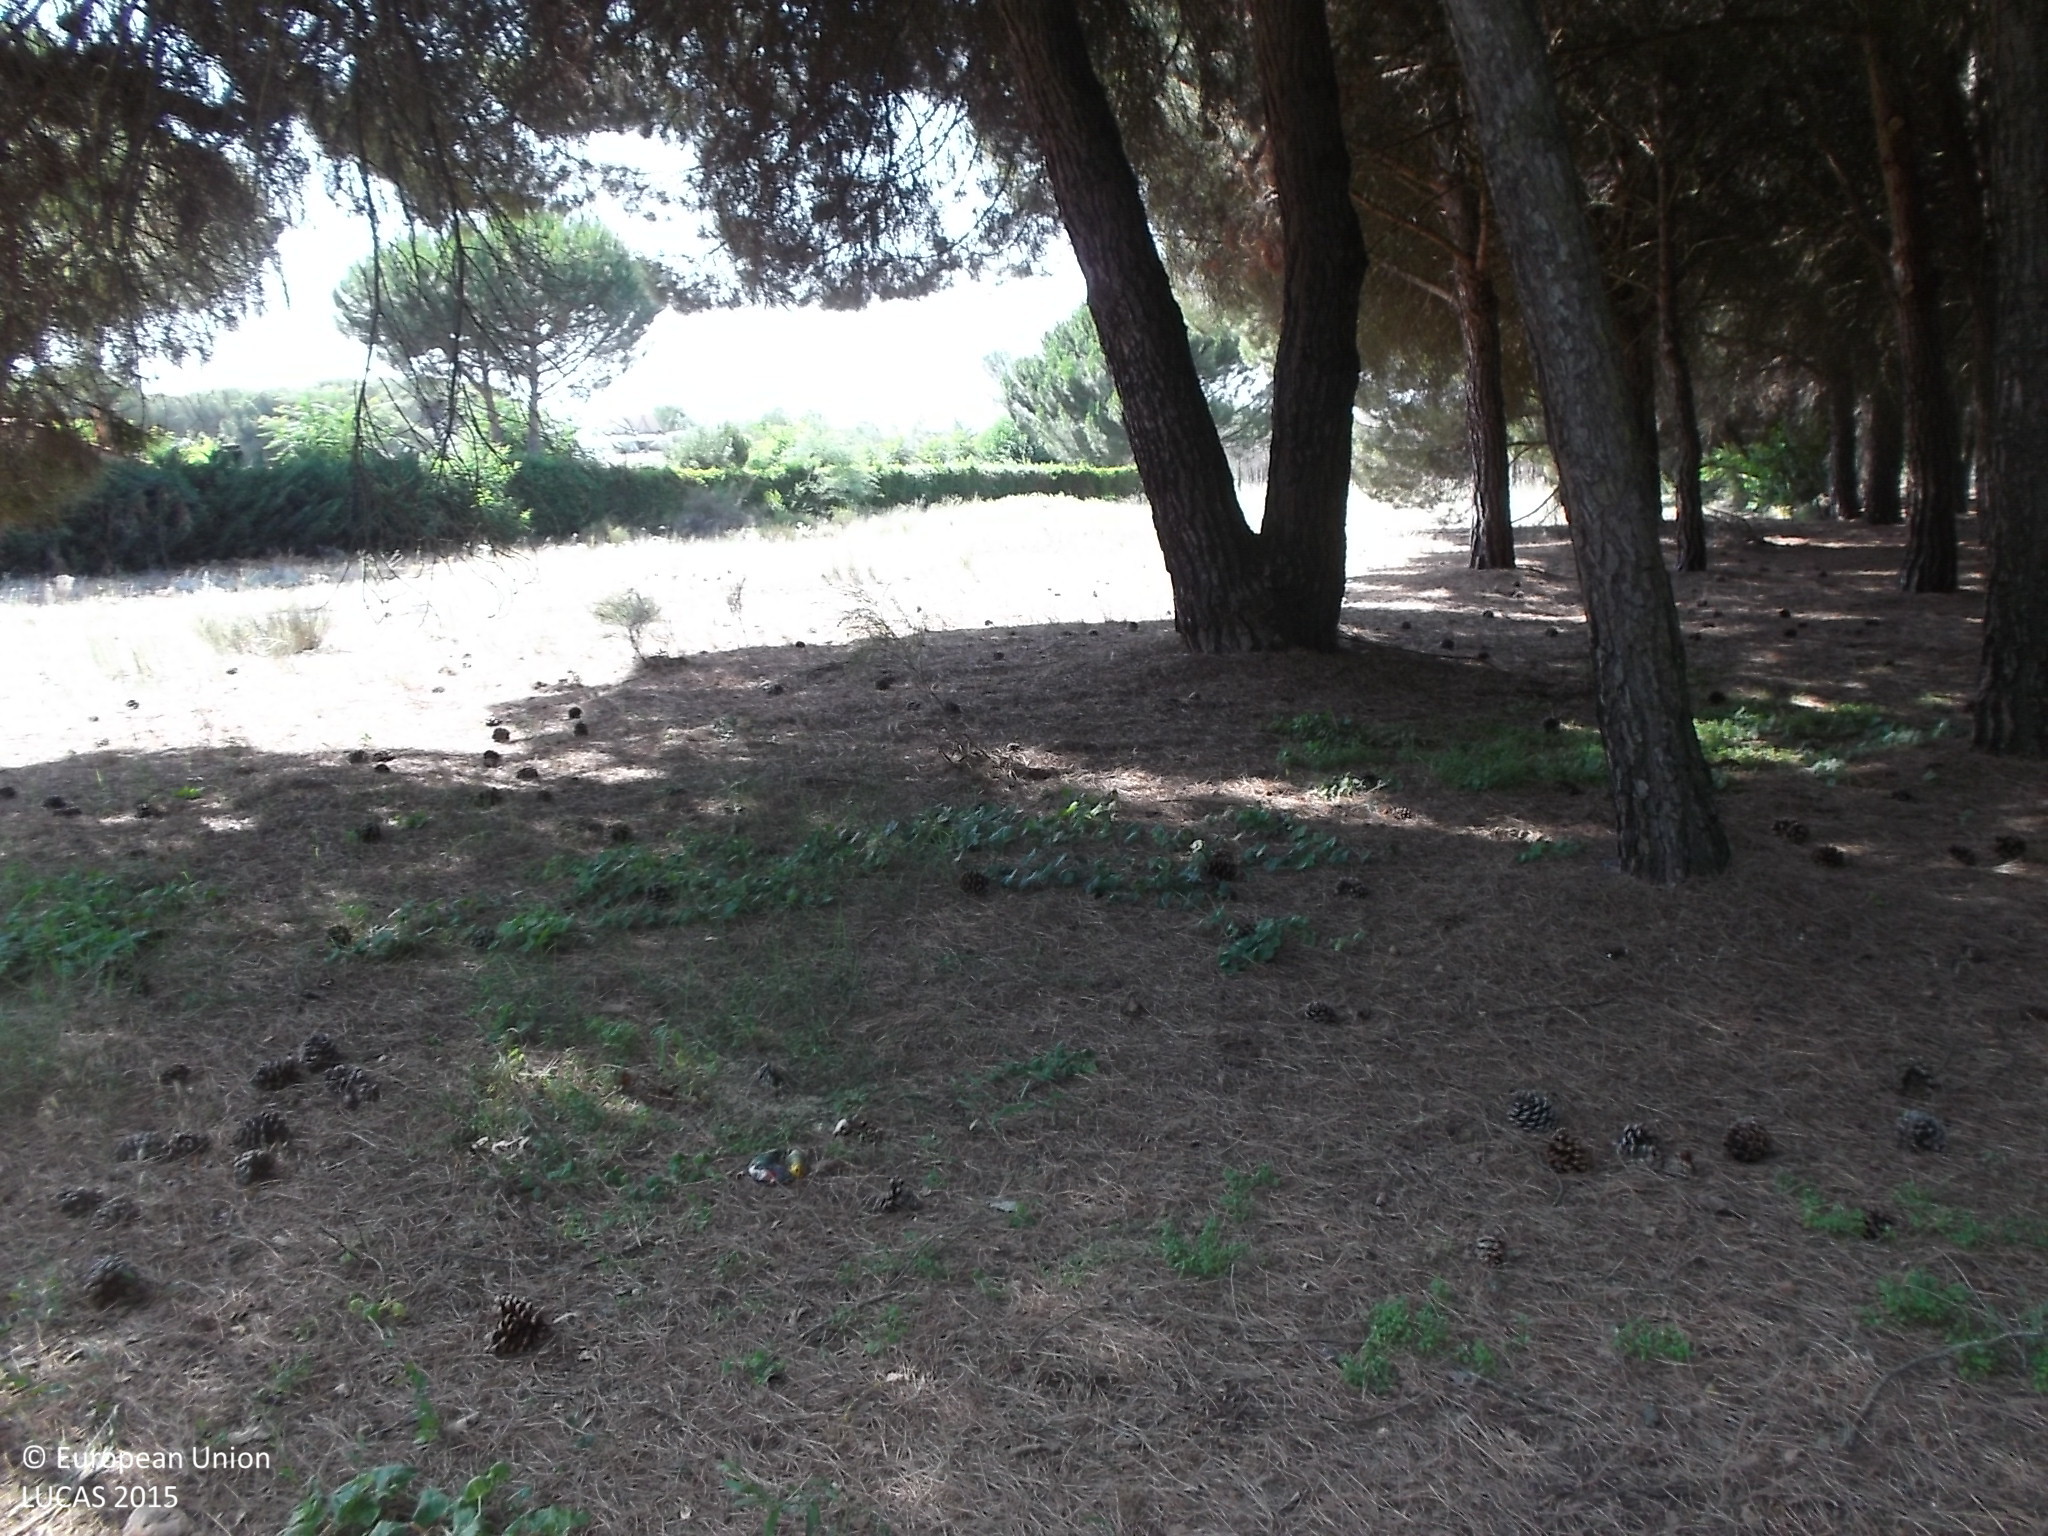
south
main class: Woodland
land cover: Broadleaved woodland
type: broadleaved evergreen forest
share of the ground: > 75 %
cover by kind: broadleaved forest trees 80 %, herbaceous plants 20 %
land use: Residential
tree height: < 5 m
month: July
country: ES
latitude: 41.4904
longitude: -5.3745
